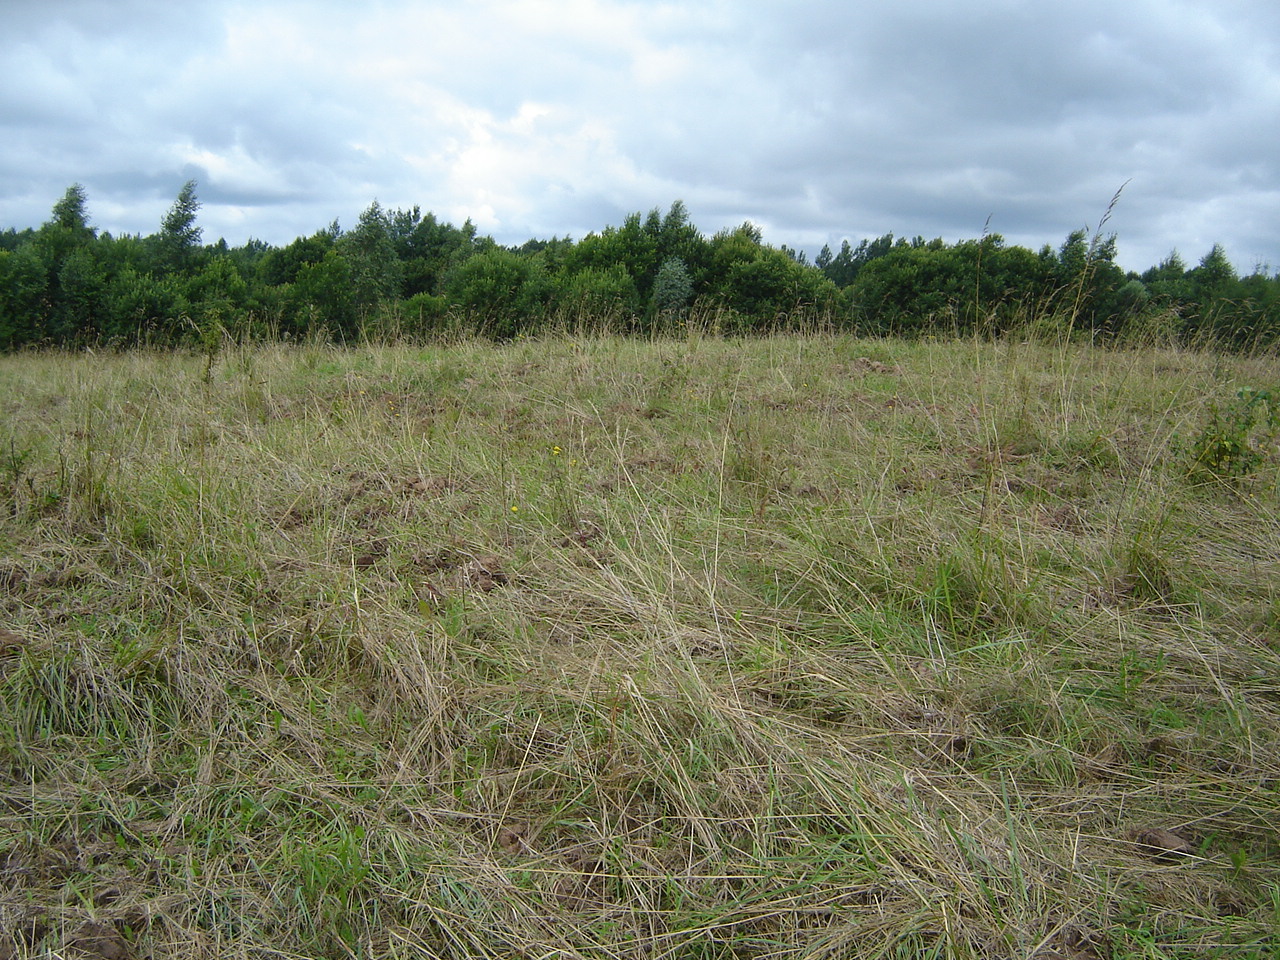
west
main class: Grassland
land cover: Spontaneously vegetated surfaces
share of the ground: > 75 %
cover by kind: herbaceous plants 95 %, shrubs 5 %
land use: Fallow land
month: July
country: LT
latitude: 55.2917
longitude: 25.0584
